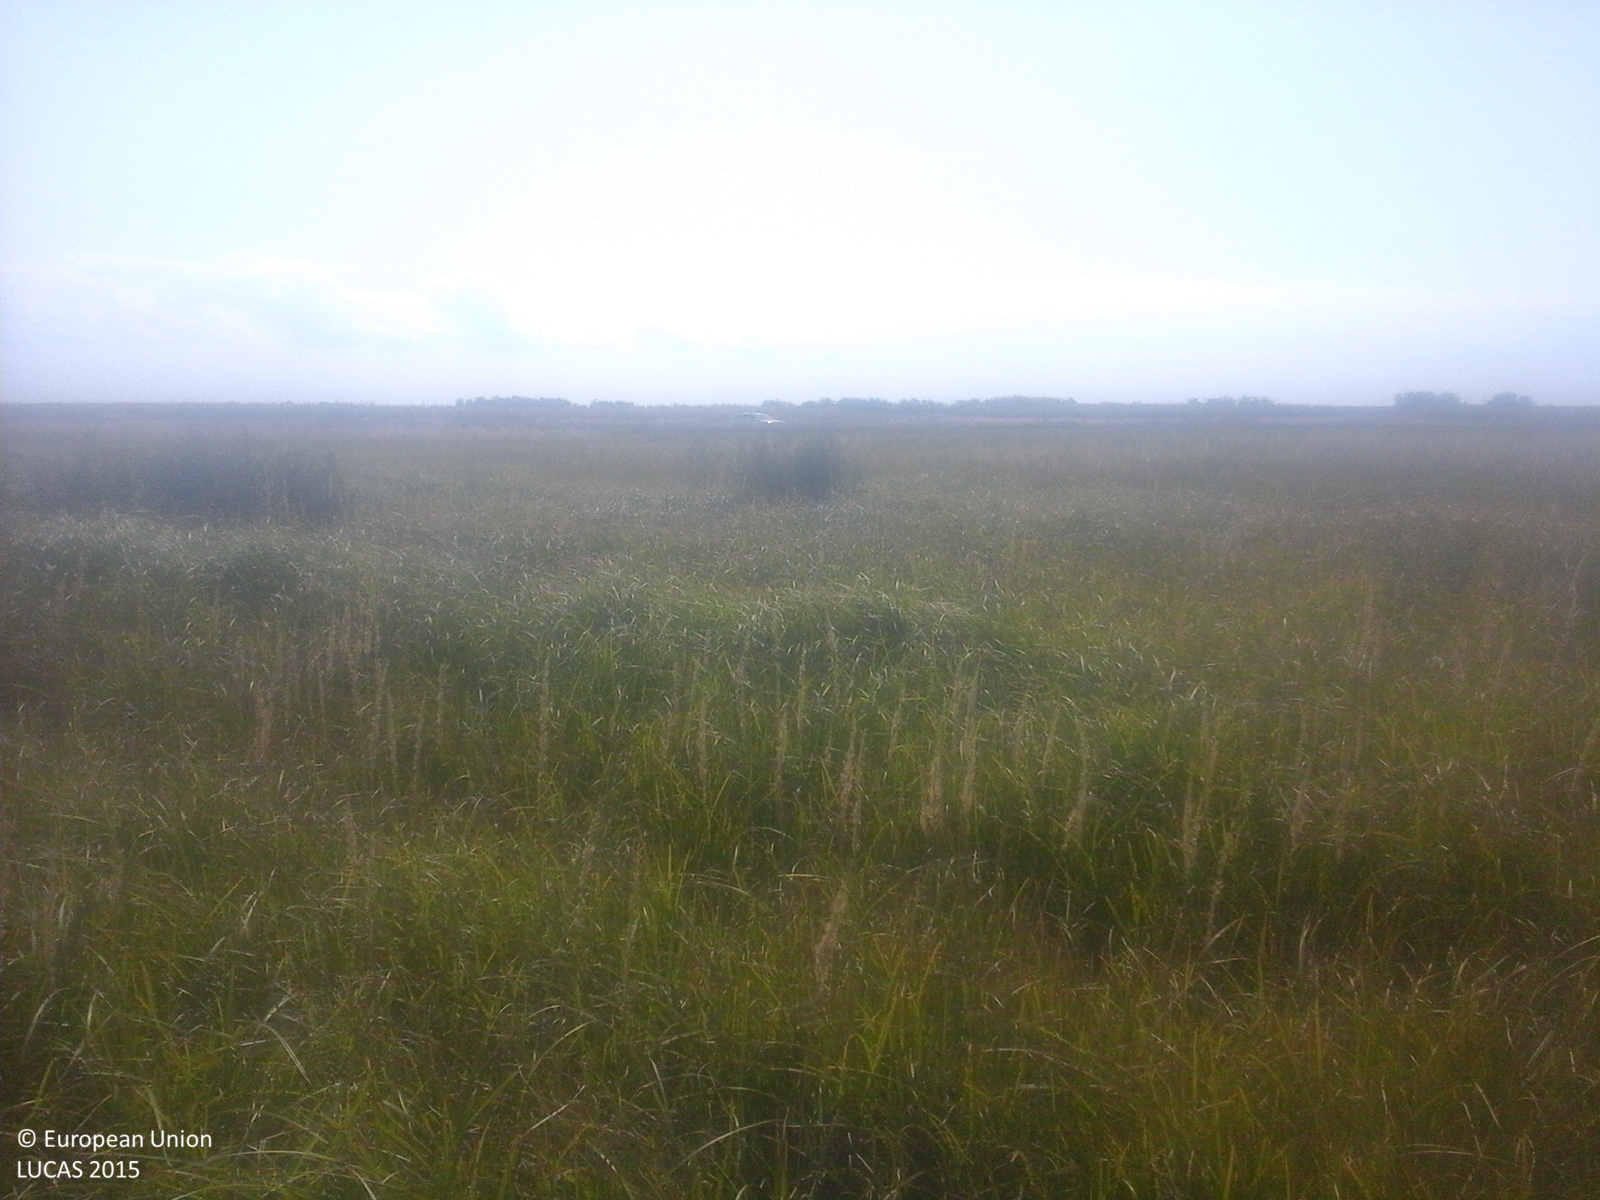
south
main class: Grassland
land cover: Spontaneously vegetated surfaces
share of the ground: > 75 %
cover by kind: herbaceous plants 100 %
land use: Fallow land
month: September
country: RO
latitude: 47.7538
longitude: 22.5854
